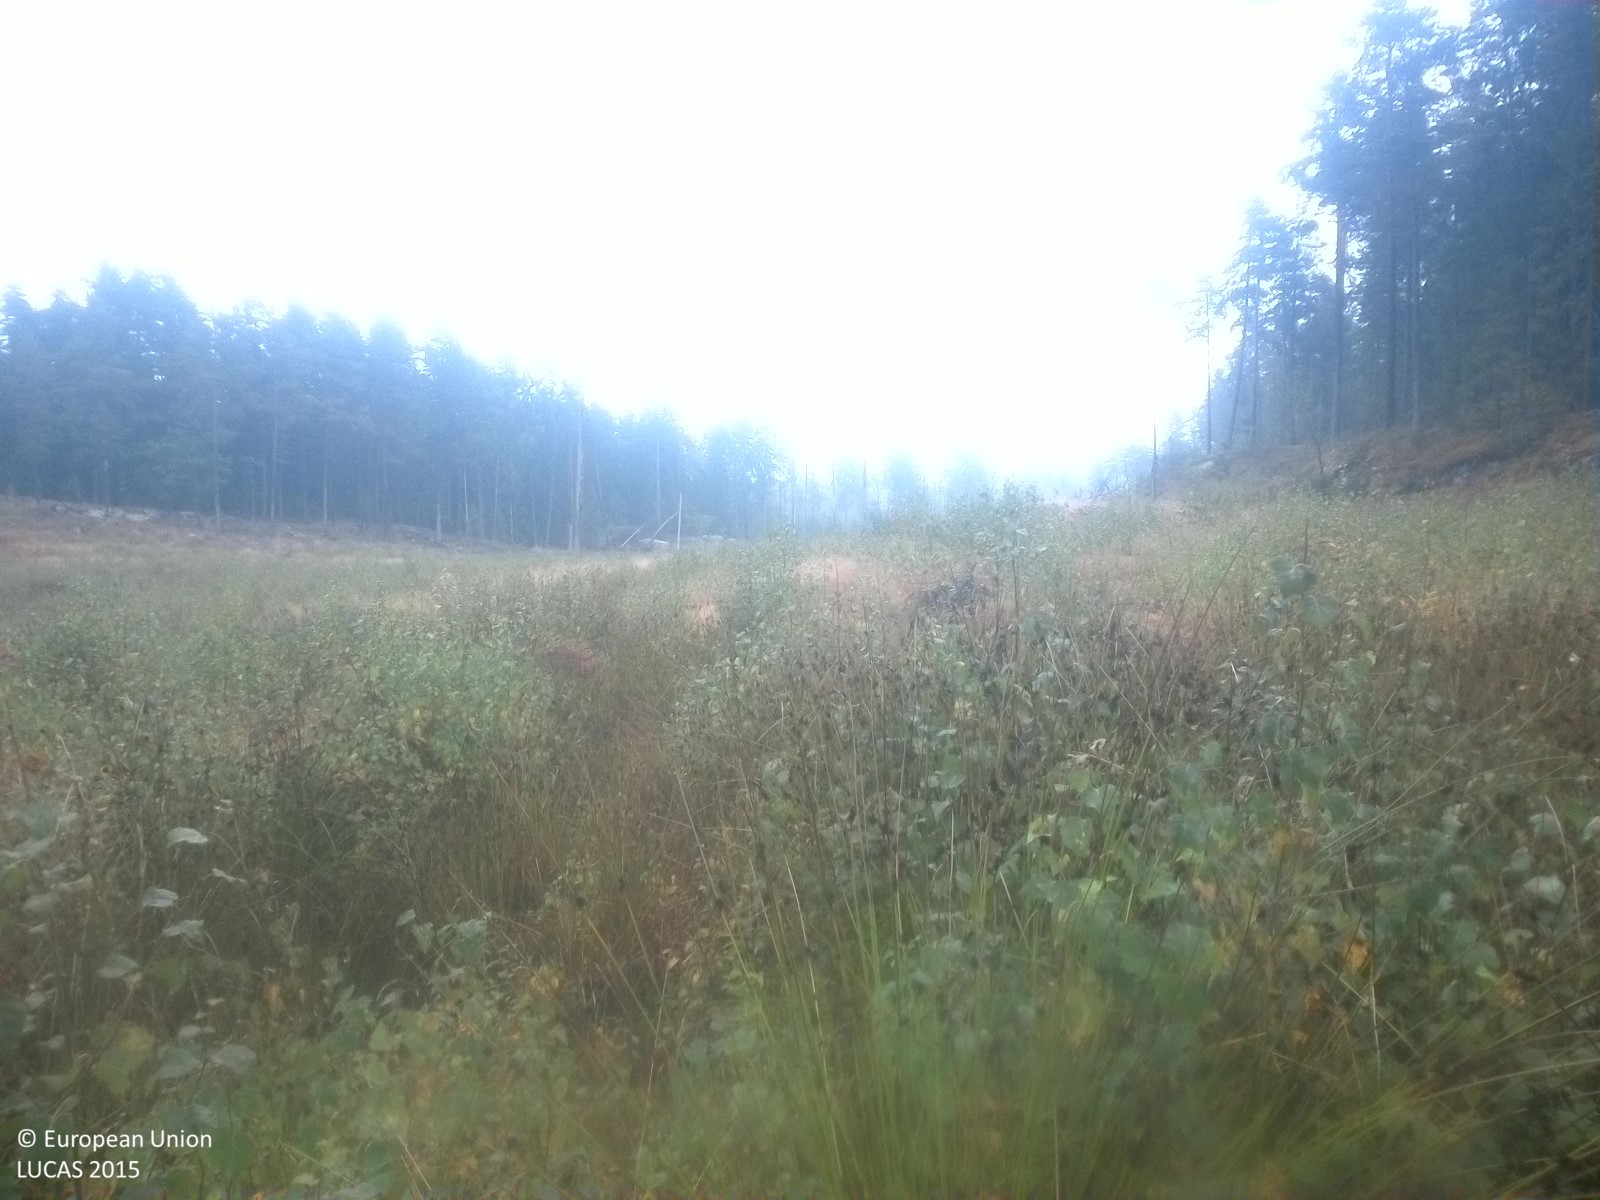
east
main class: Woodland
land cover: Broadleaved woodland
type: boreal forest
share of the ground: 50 - 75 %
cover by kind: broadleaved forest trees 55 %, herbaceous plants 35 %, coniferous forest trees 5 %, lichens and mosses 5 %
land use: Forestry
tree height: < 5 m
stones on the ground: 10 - 25 %
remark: Clear cut
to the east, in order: Broadleaved woodland; Grassland with sparse tree/shrub cover; Broadleaved woodland; Spruce dominated coniferous woodland
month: September
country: SE
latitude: 58.5197
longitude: 16.7441
